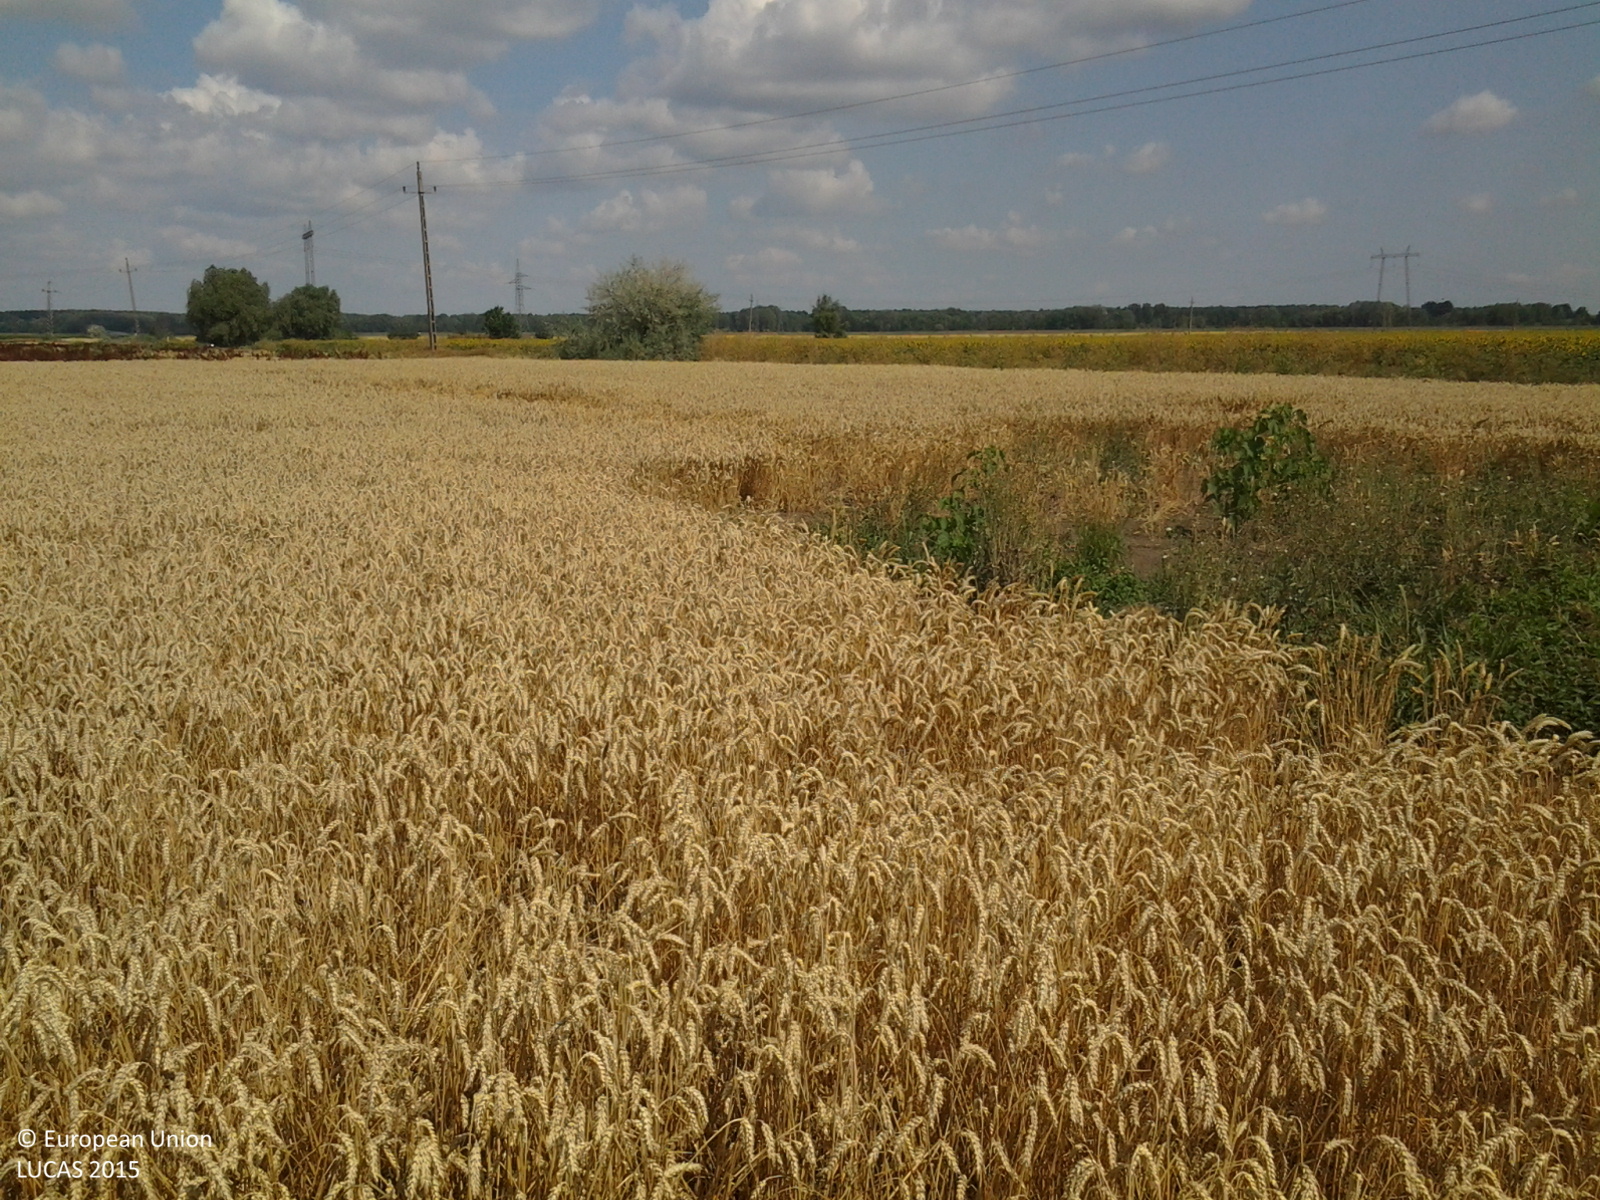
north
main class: Cropland
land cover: Common wheat
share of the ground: > 75 %
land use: Agriculture (excluding fallow land and kitchen gardens)
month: July
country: HU
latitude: 46.9251
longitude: 20.6546
